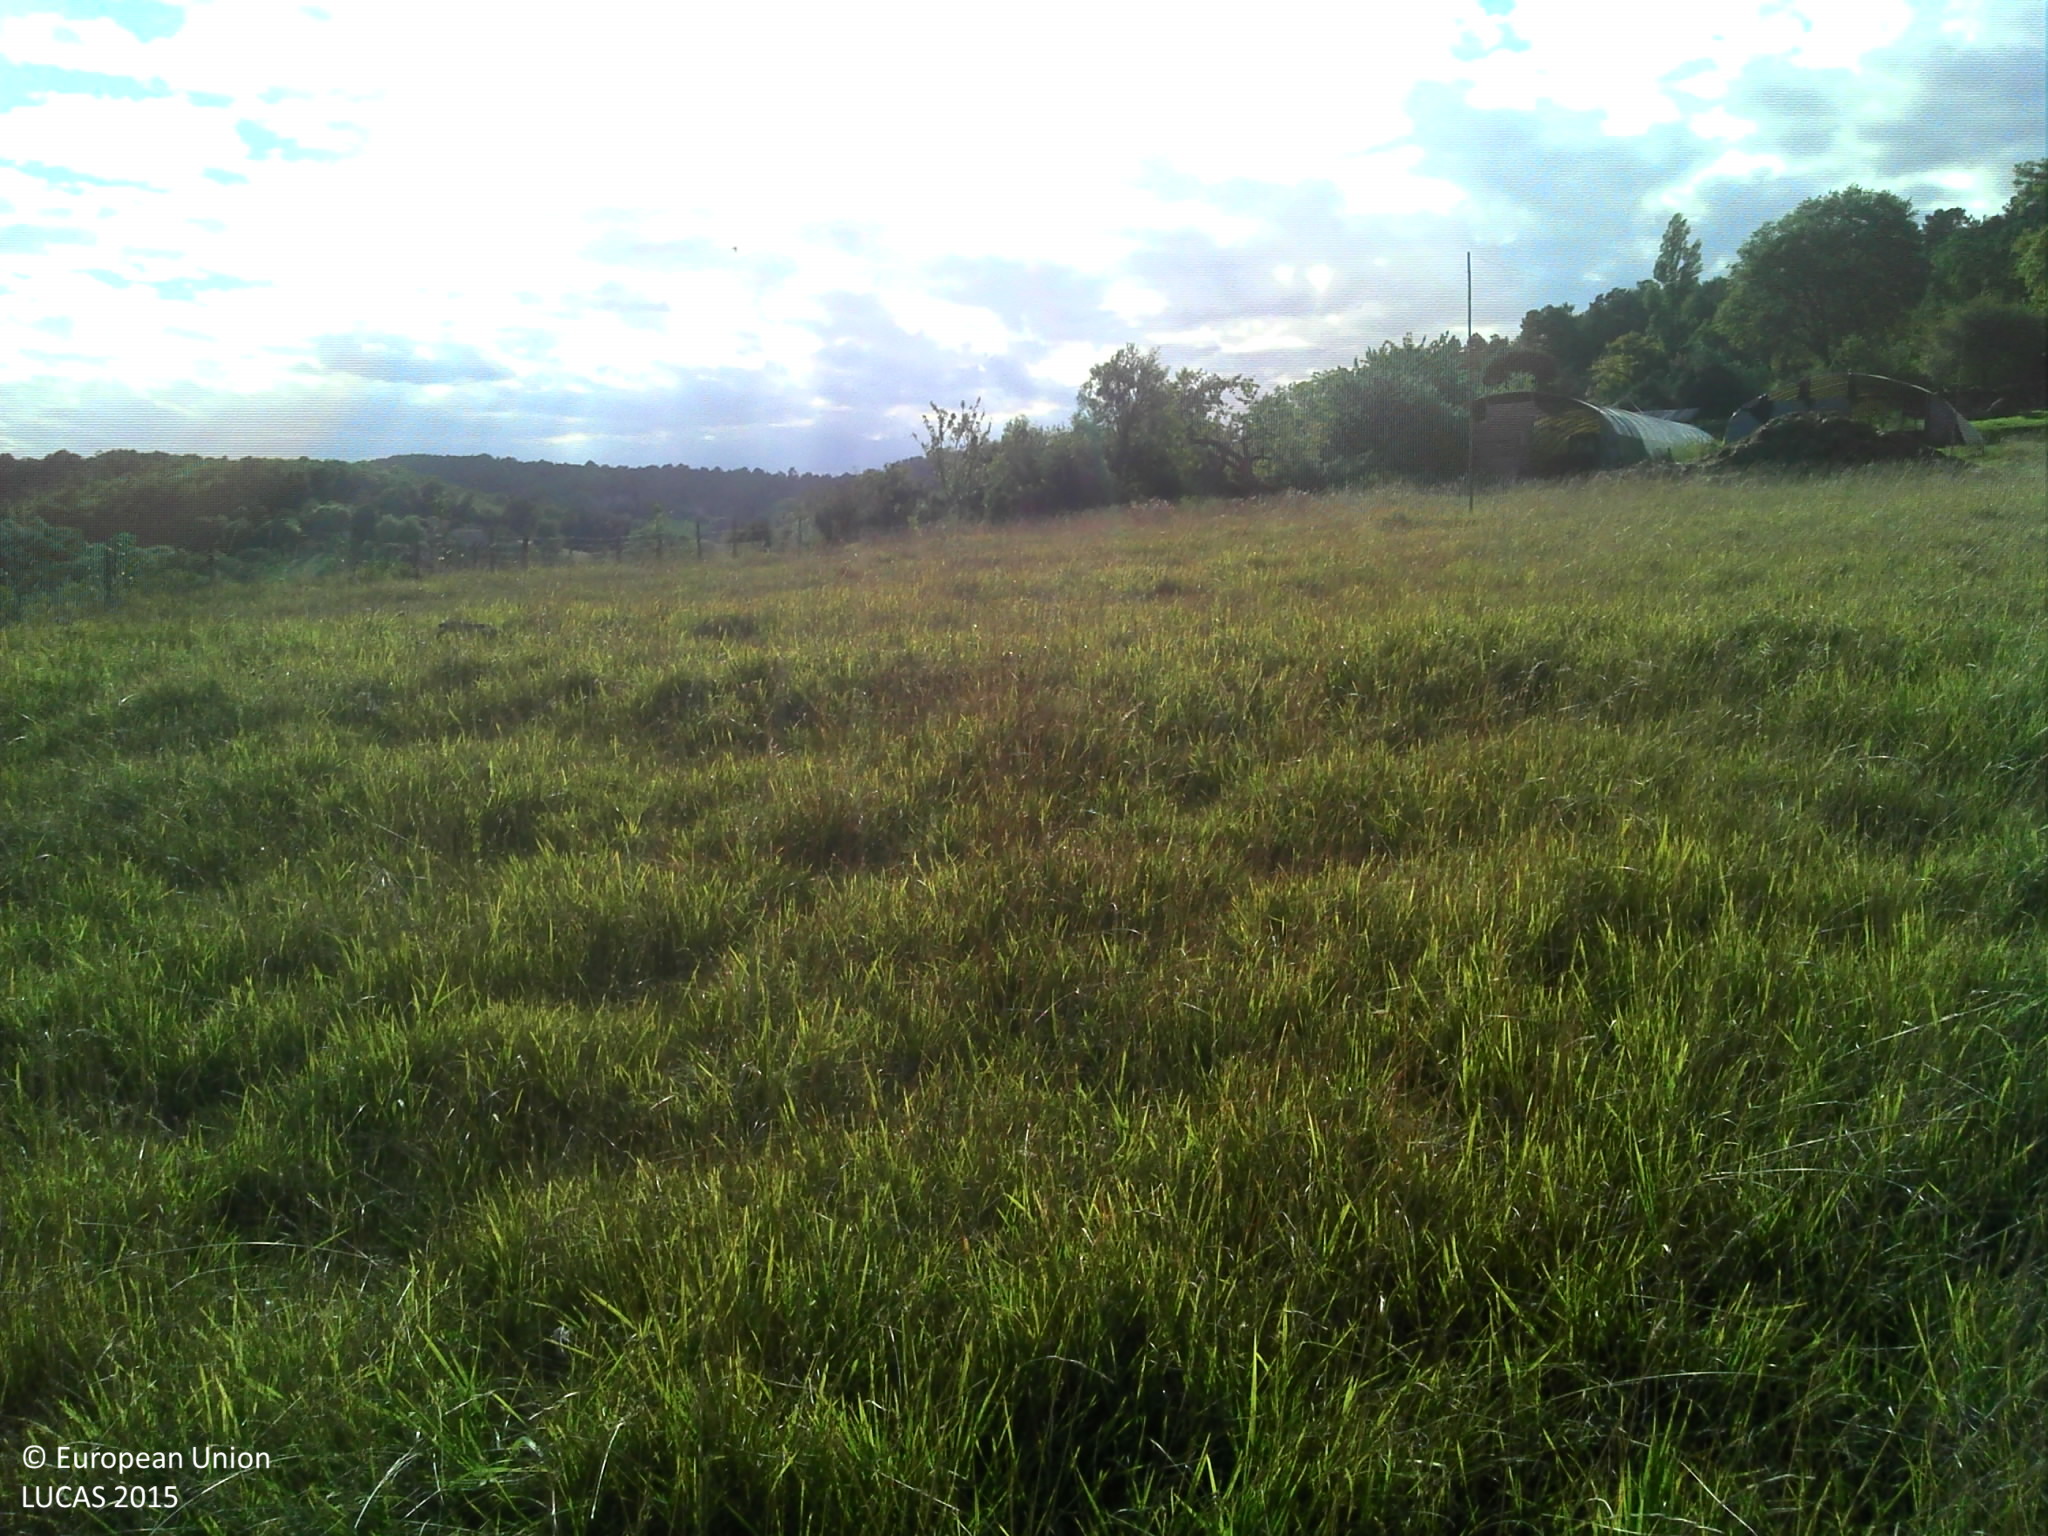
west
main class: Grassland
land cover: Grassland without tree/shrub cover
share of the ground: > 75 %
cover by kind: herbaceous plants 90 %, lichens and mosses 10 %
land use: Agriculture (excluding fallow land and kitchen gardens)
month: August
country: FR
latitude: 45.1869
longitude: 0.5324
